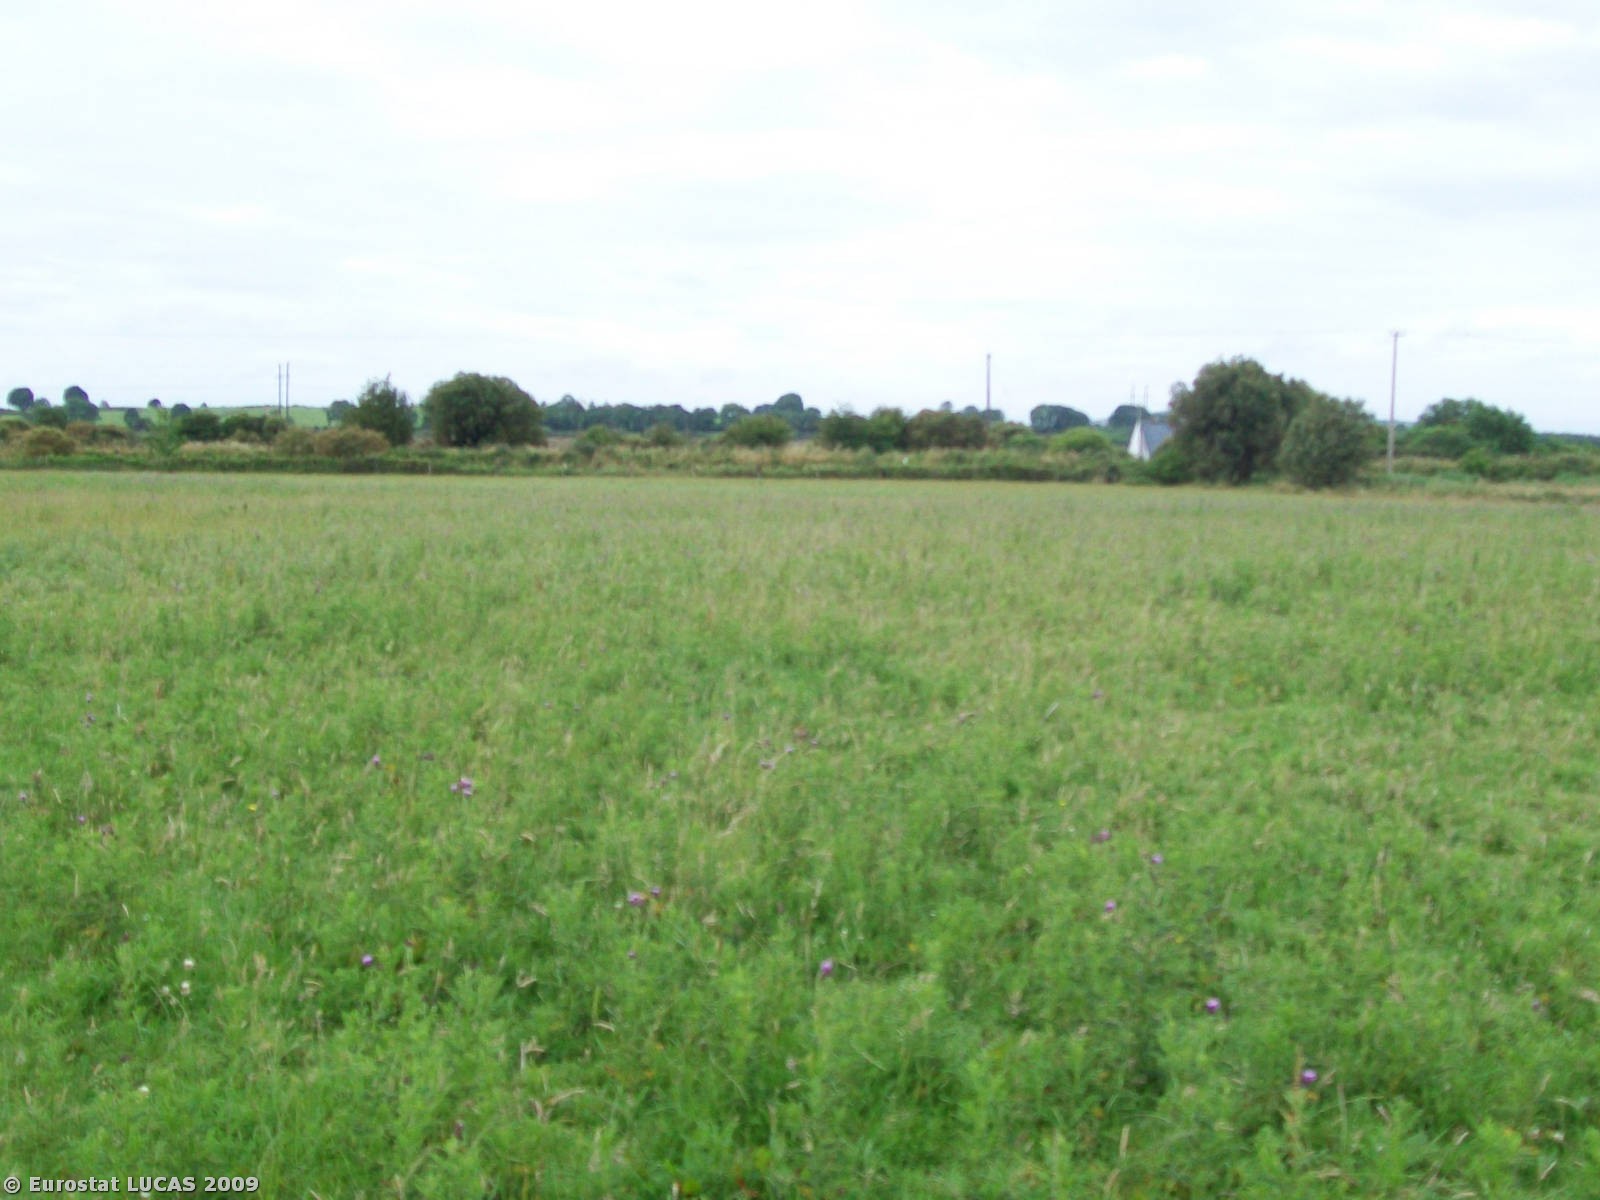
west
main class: Grassland
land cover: Grassland without tree/shrub cover
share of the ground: > 75 %
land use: Agriculture (excluding fallow land and kitchen gardens)
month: July
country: IE
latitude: 53.4920
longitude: -8.8514
